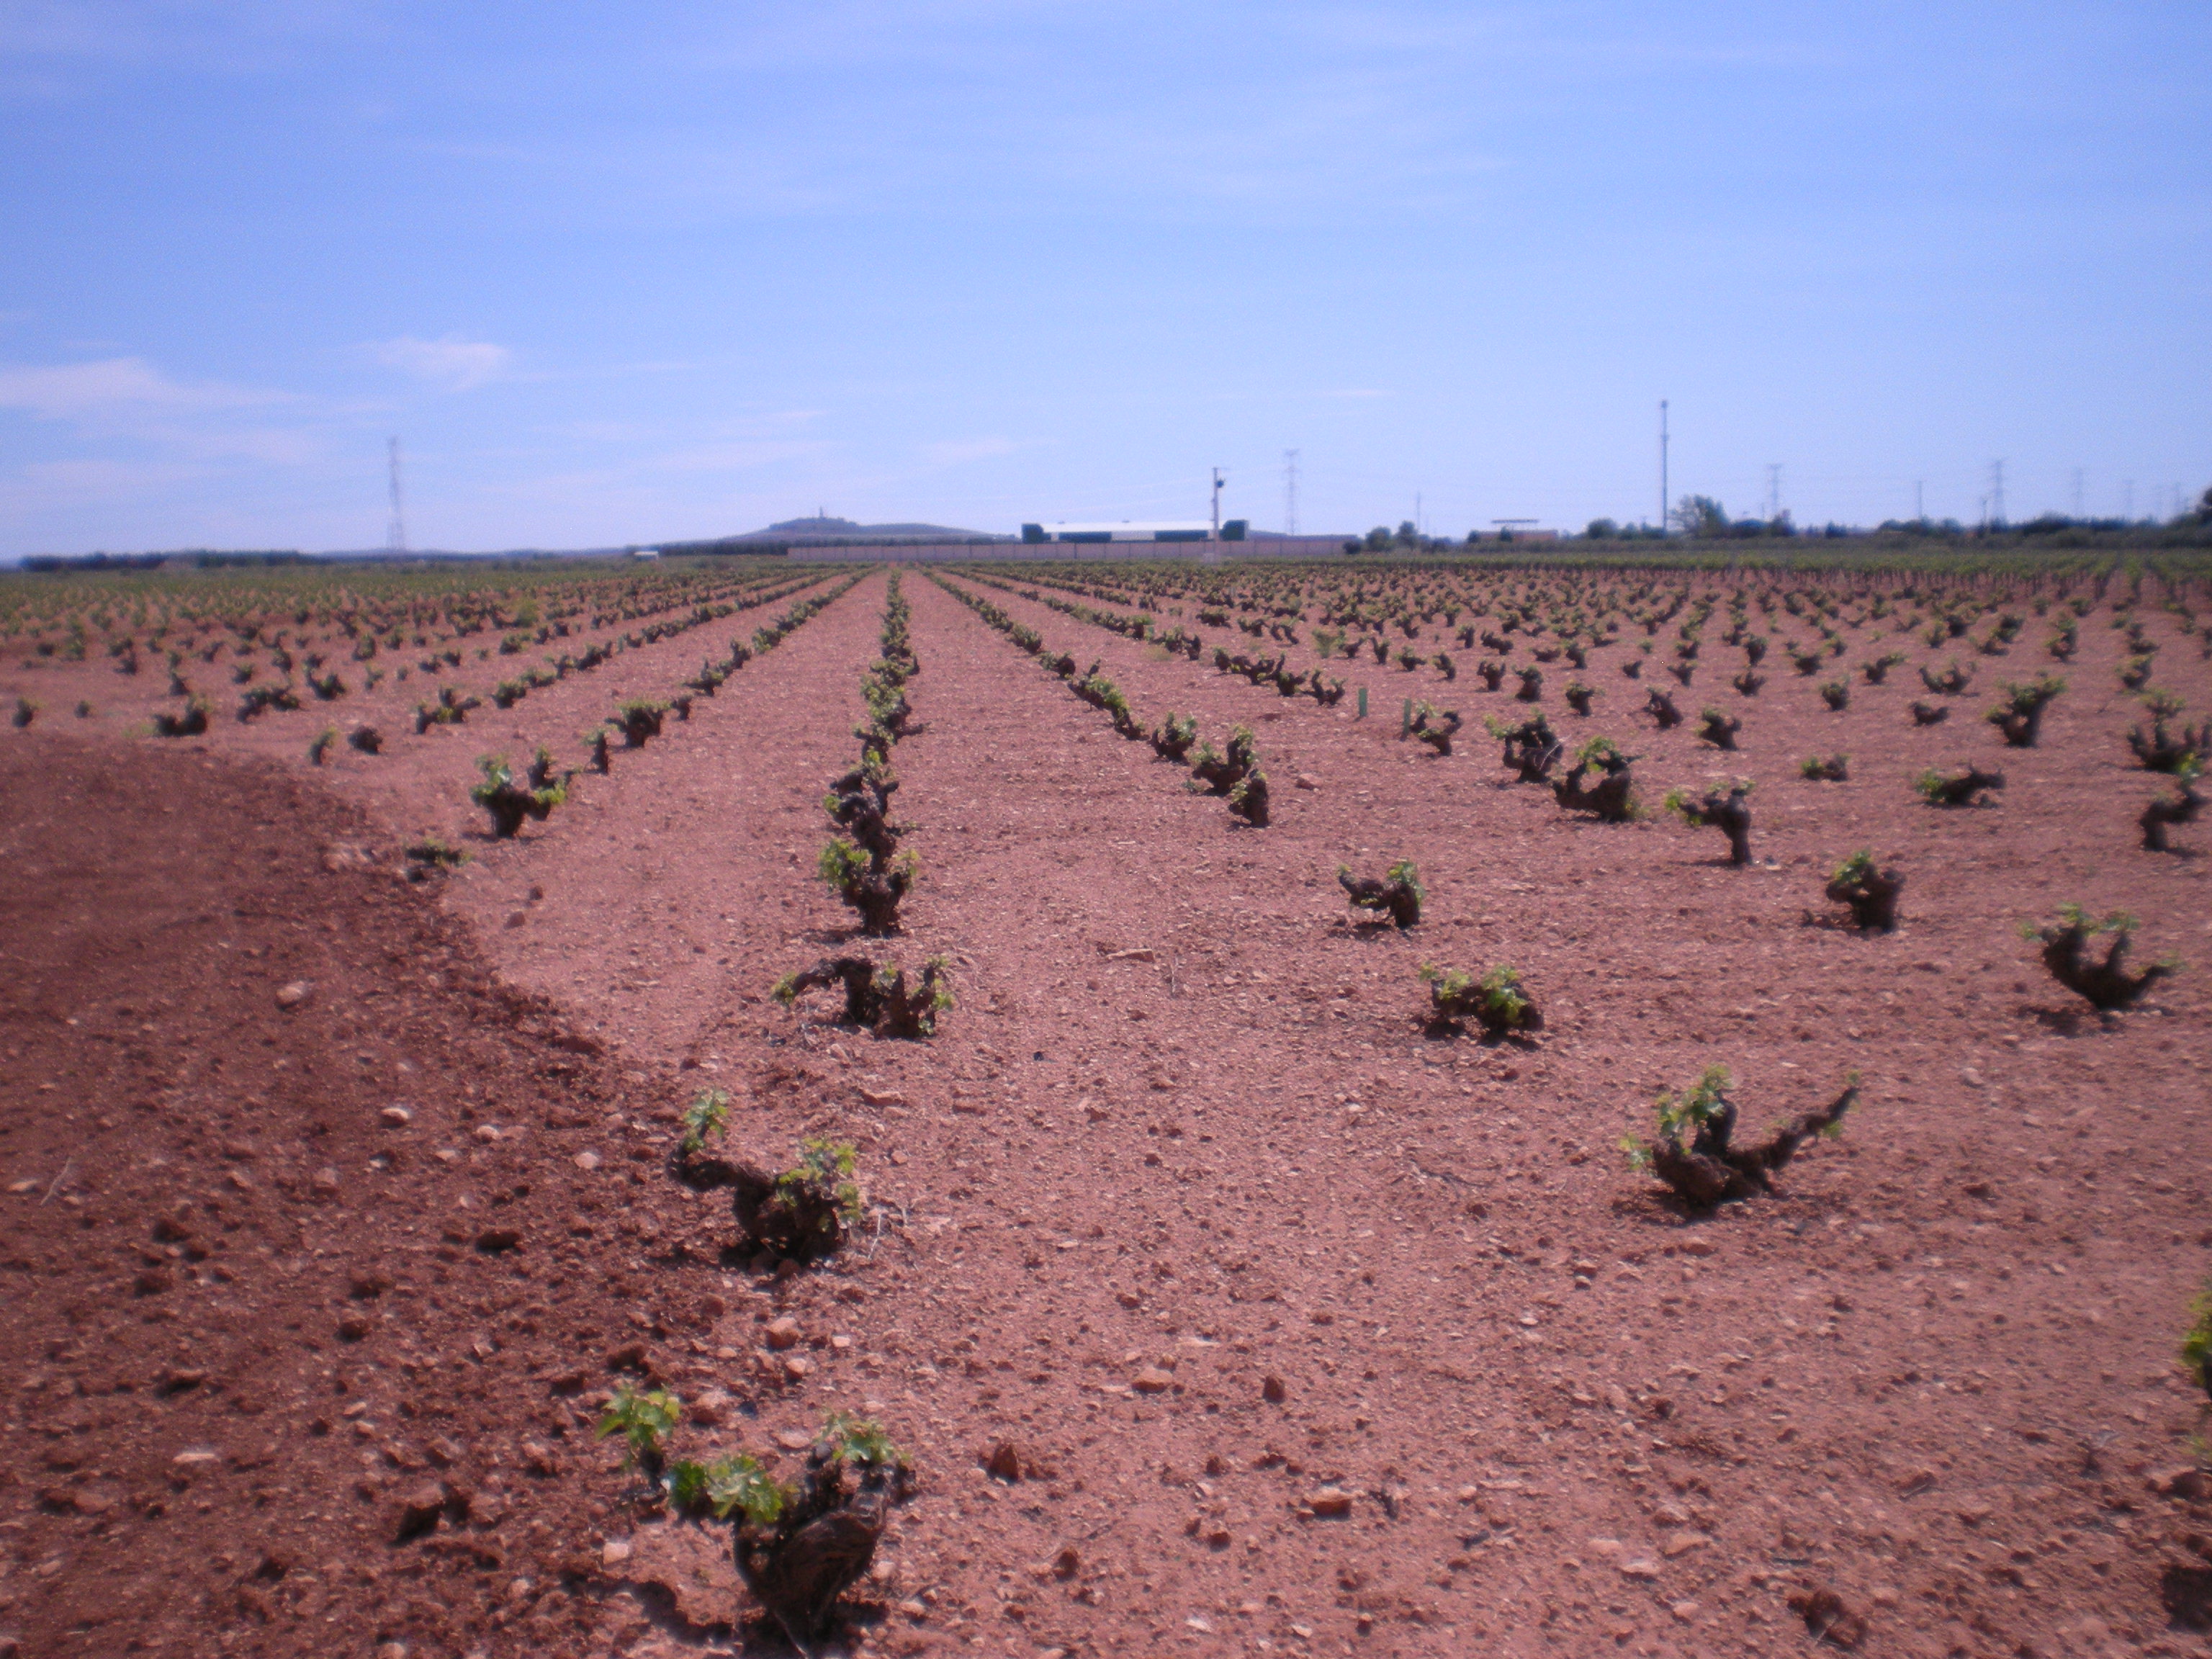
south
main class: Cropland
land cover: Vineyards
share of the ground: < 10 %
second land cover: Other bare soil
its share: > 75 %
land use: Agriculture (excluding fallow land and kitchen gardens)
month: May
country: ES
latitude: 38.8503
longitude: -3.3899
